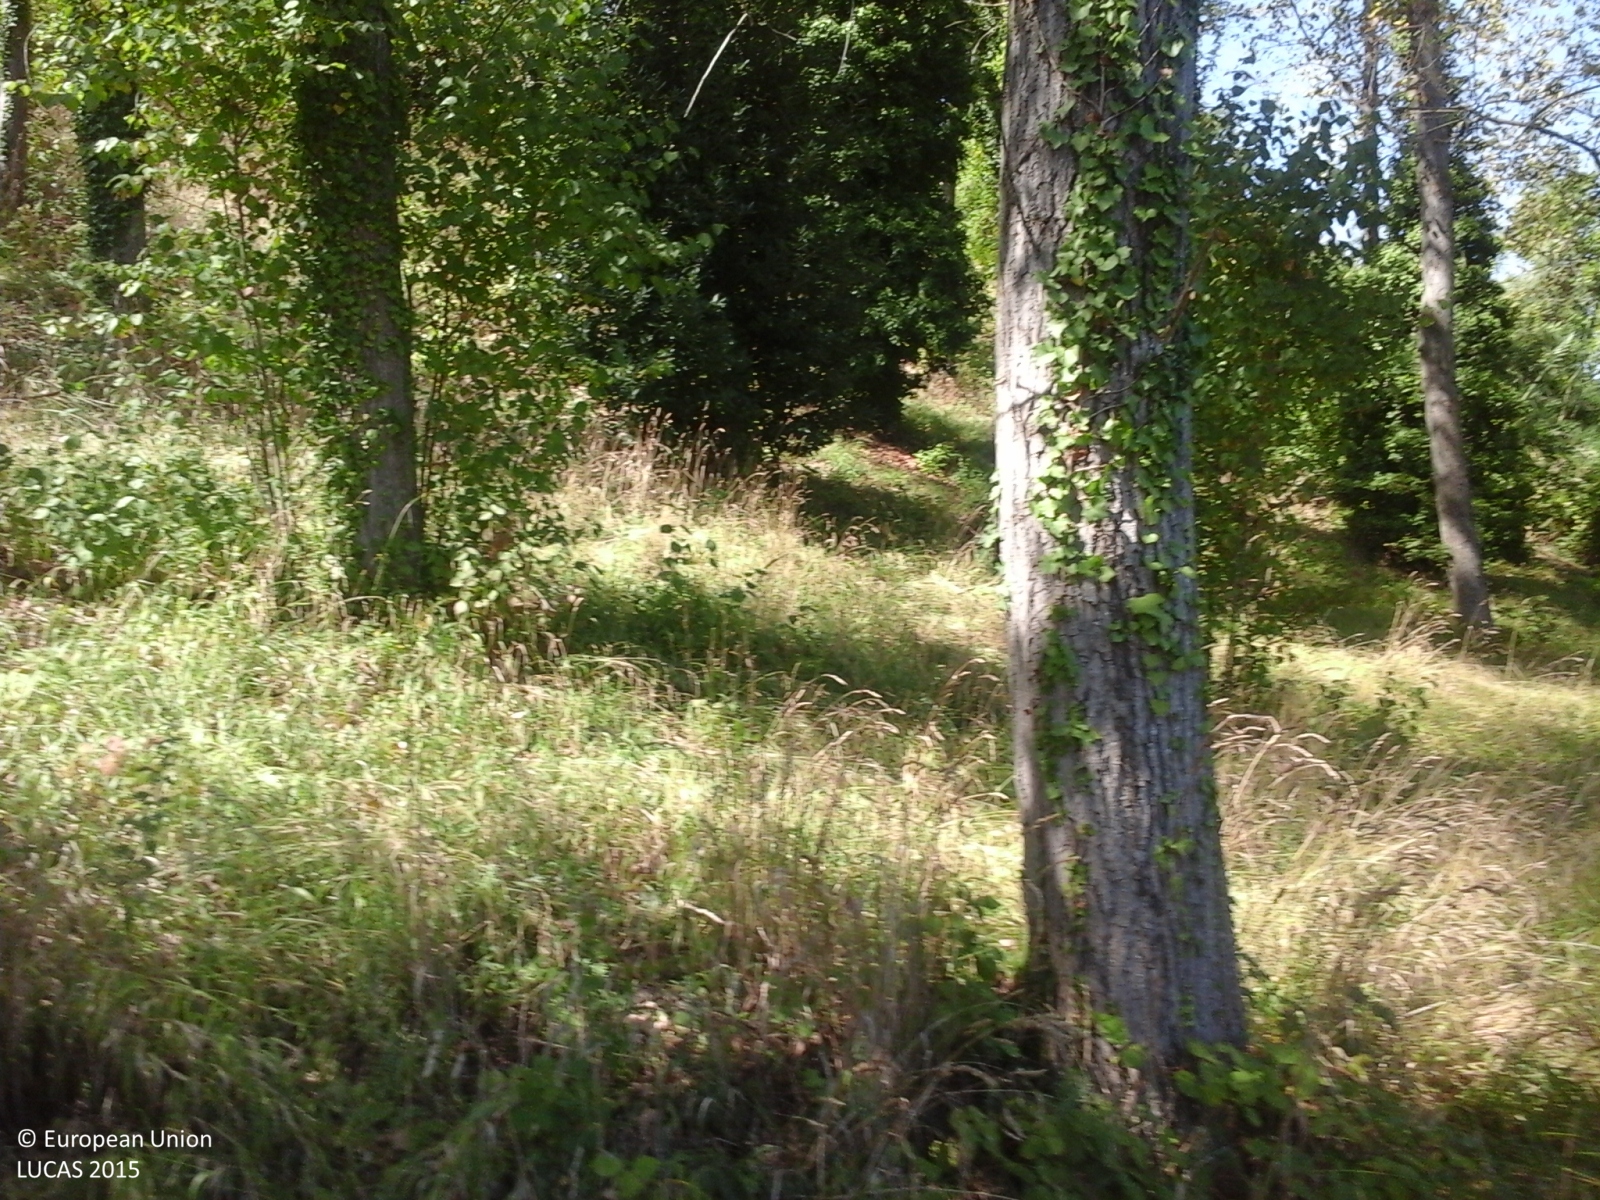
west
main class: Woodland
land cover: Broadleaved woodland
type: thermophilous deciduous forest
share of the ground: > 75 %
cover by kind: broadleaved forest trees 100 %
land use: Forestry
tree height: > 5 m
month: September
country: IT
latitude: 43.7248
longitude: 13.1580
